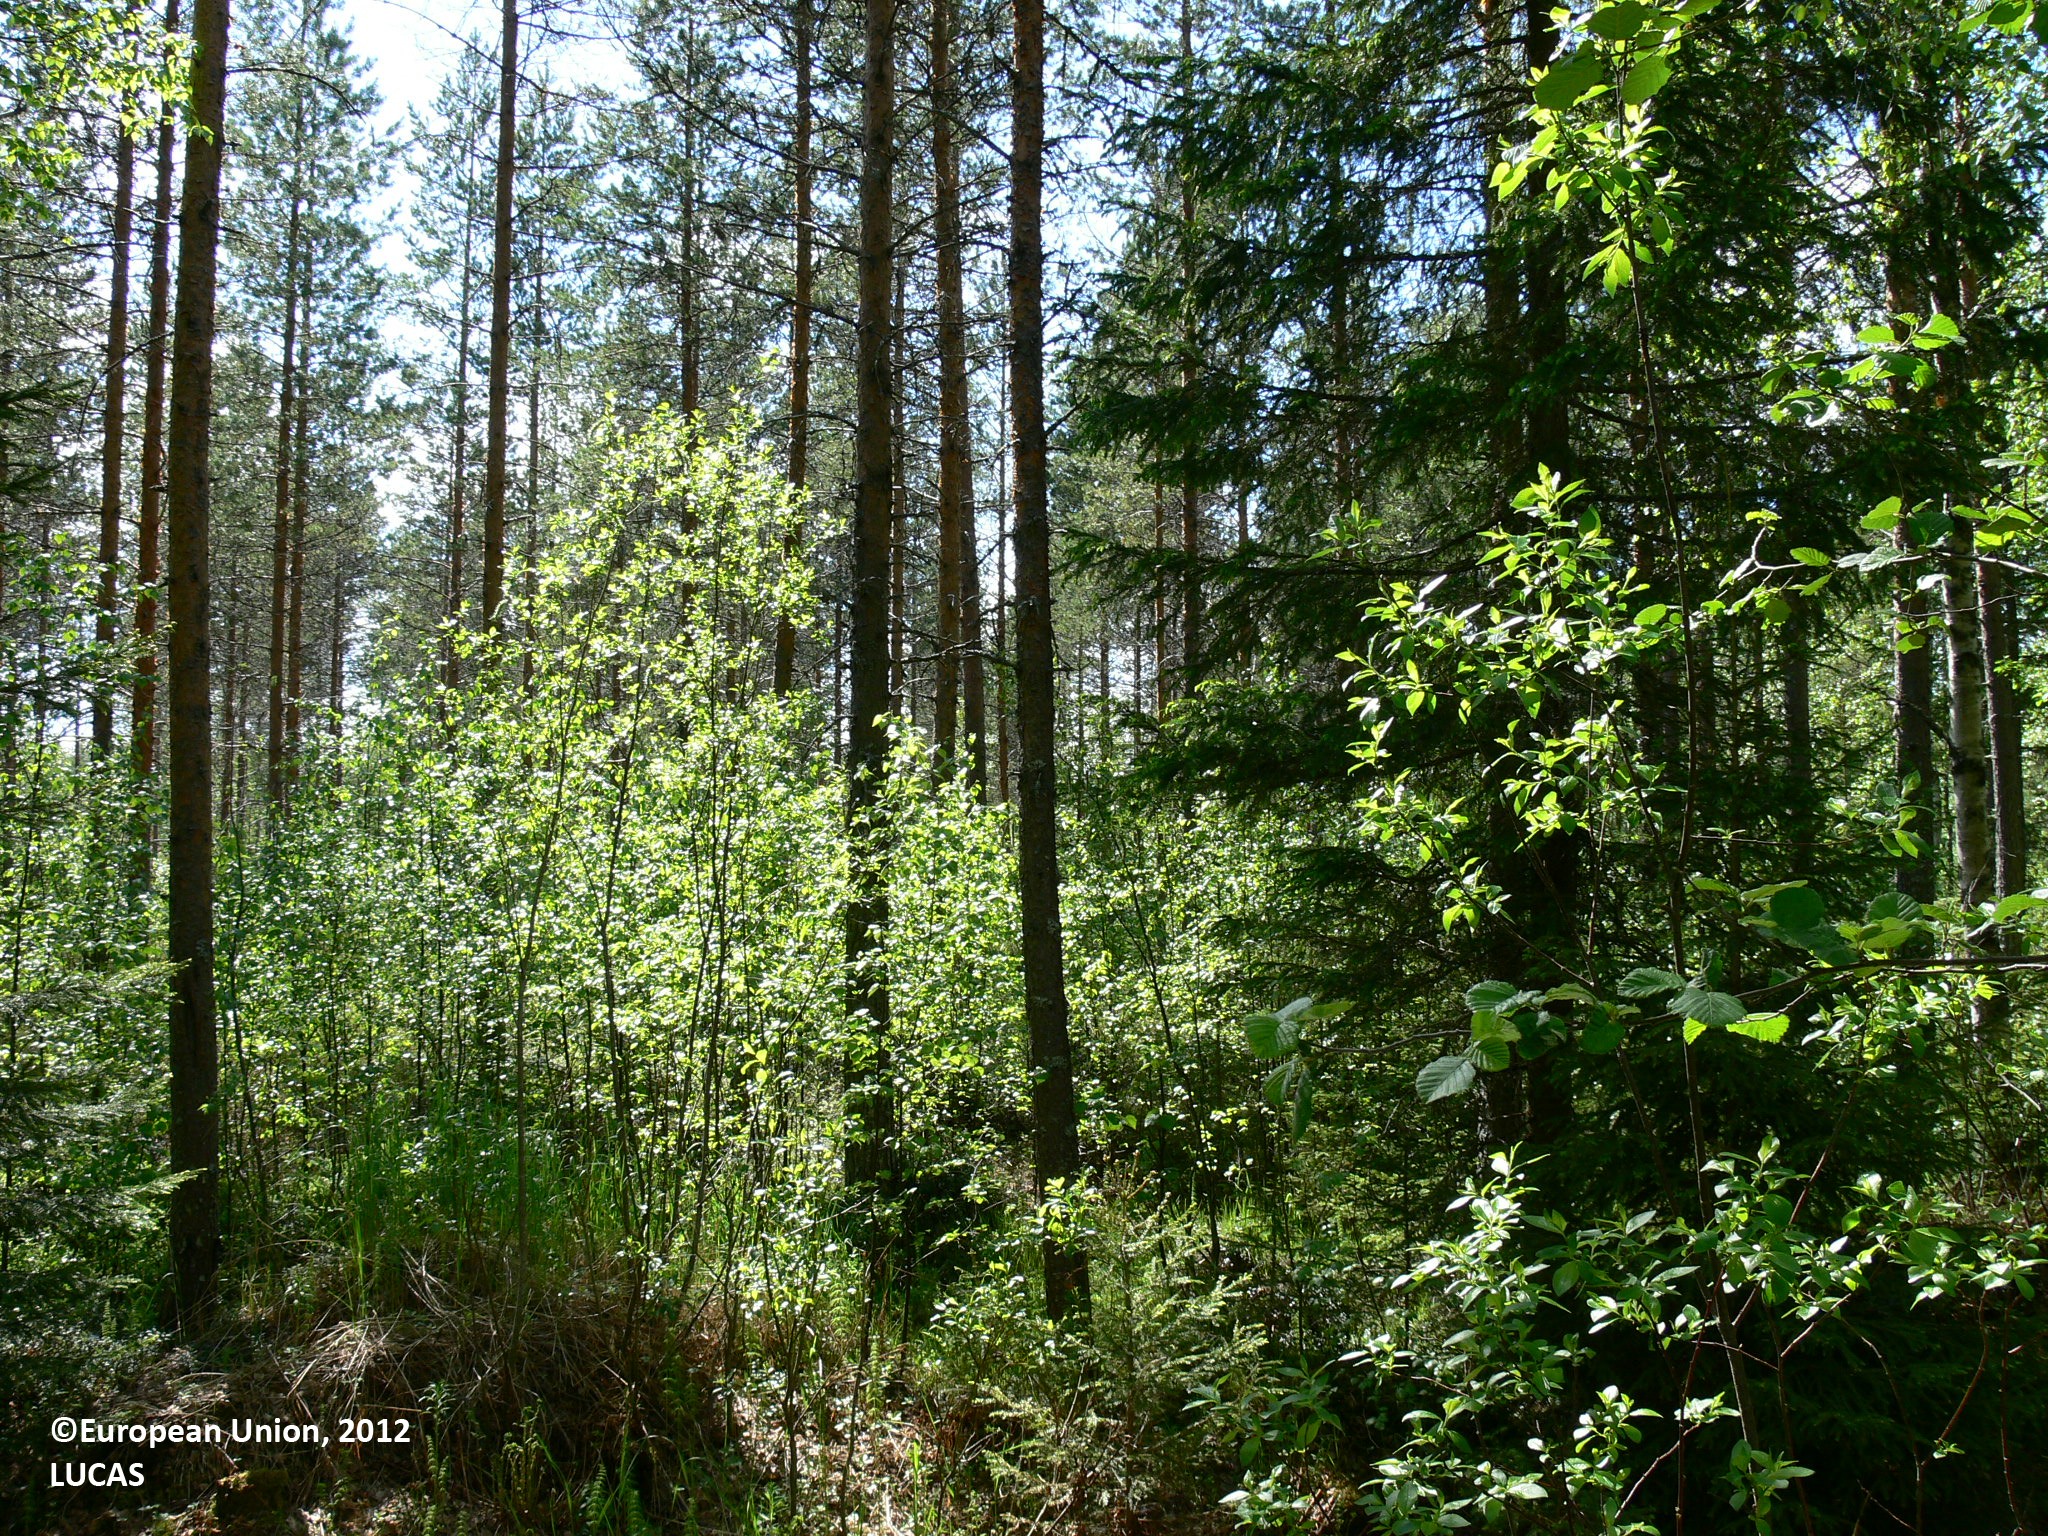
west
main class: Woodland
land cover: Other mixed woodland
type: boreal forest
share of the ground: > 75 %
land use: Forestry
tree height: > 5 m
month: June
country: FI
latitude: 62.5961
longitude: 30.8027
